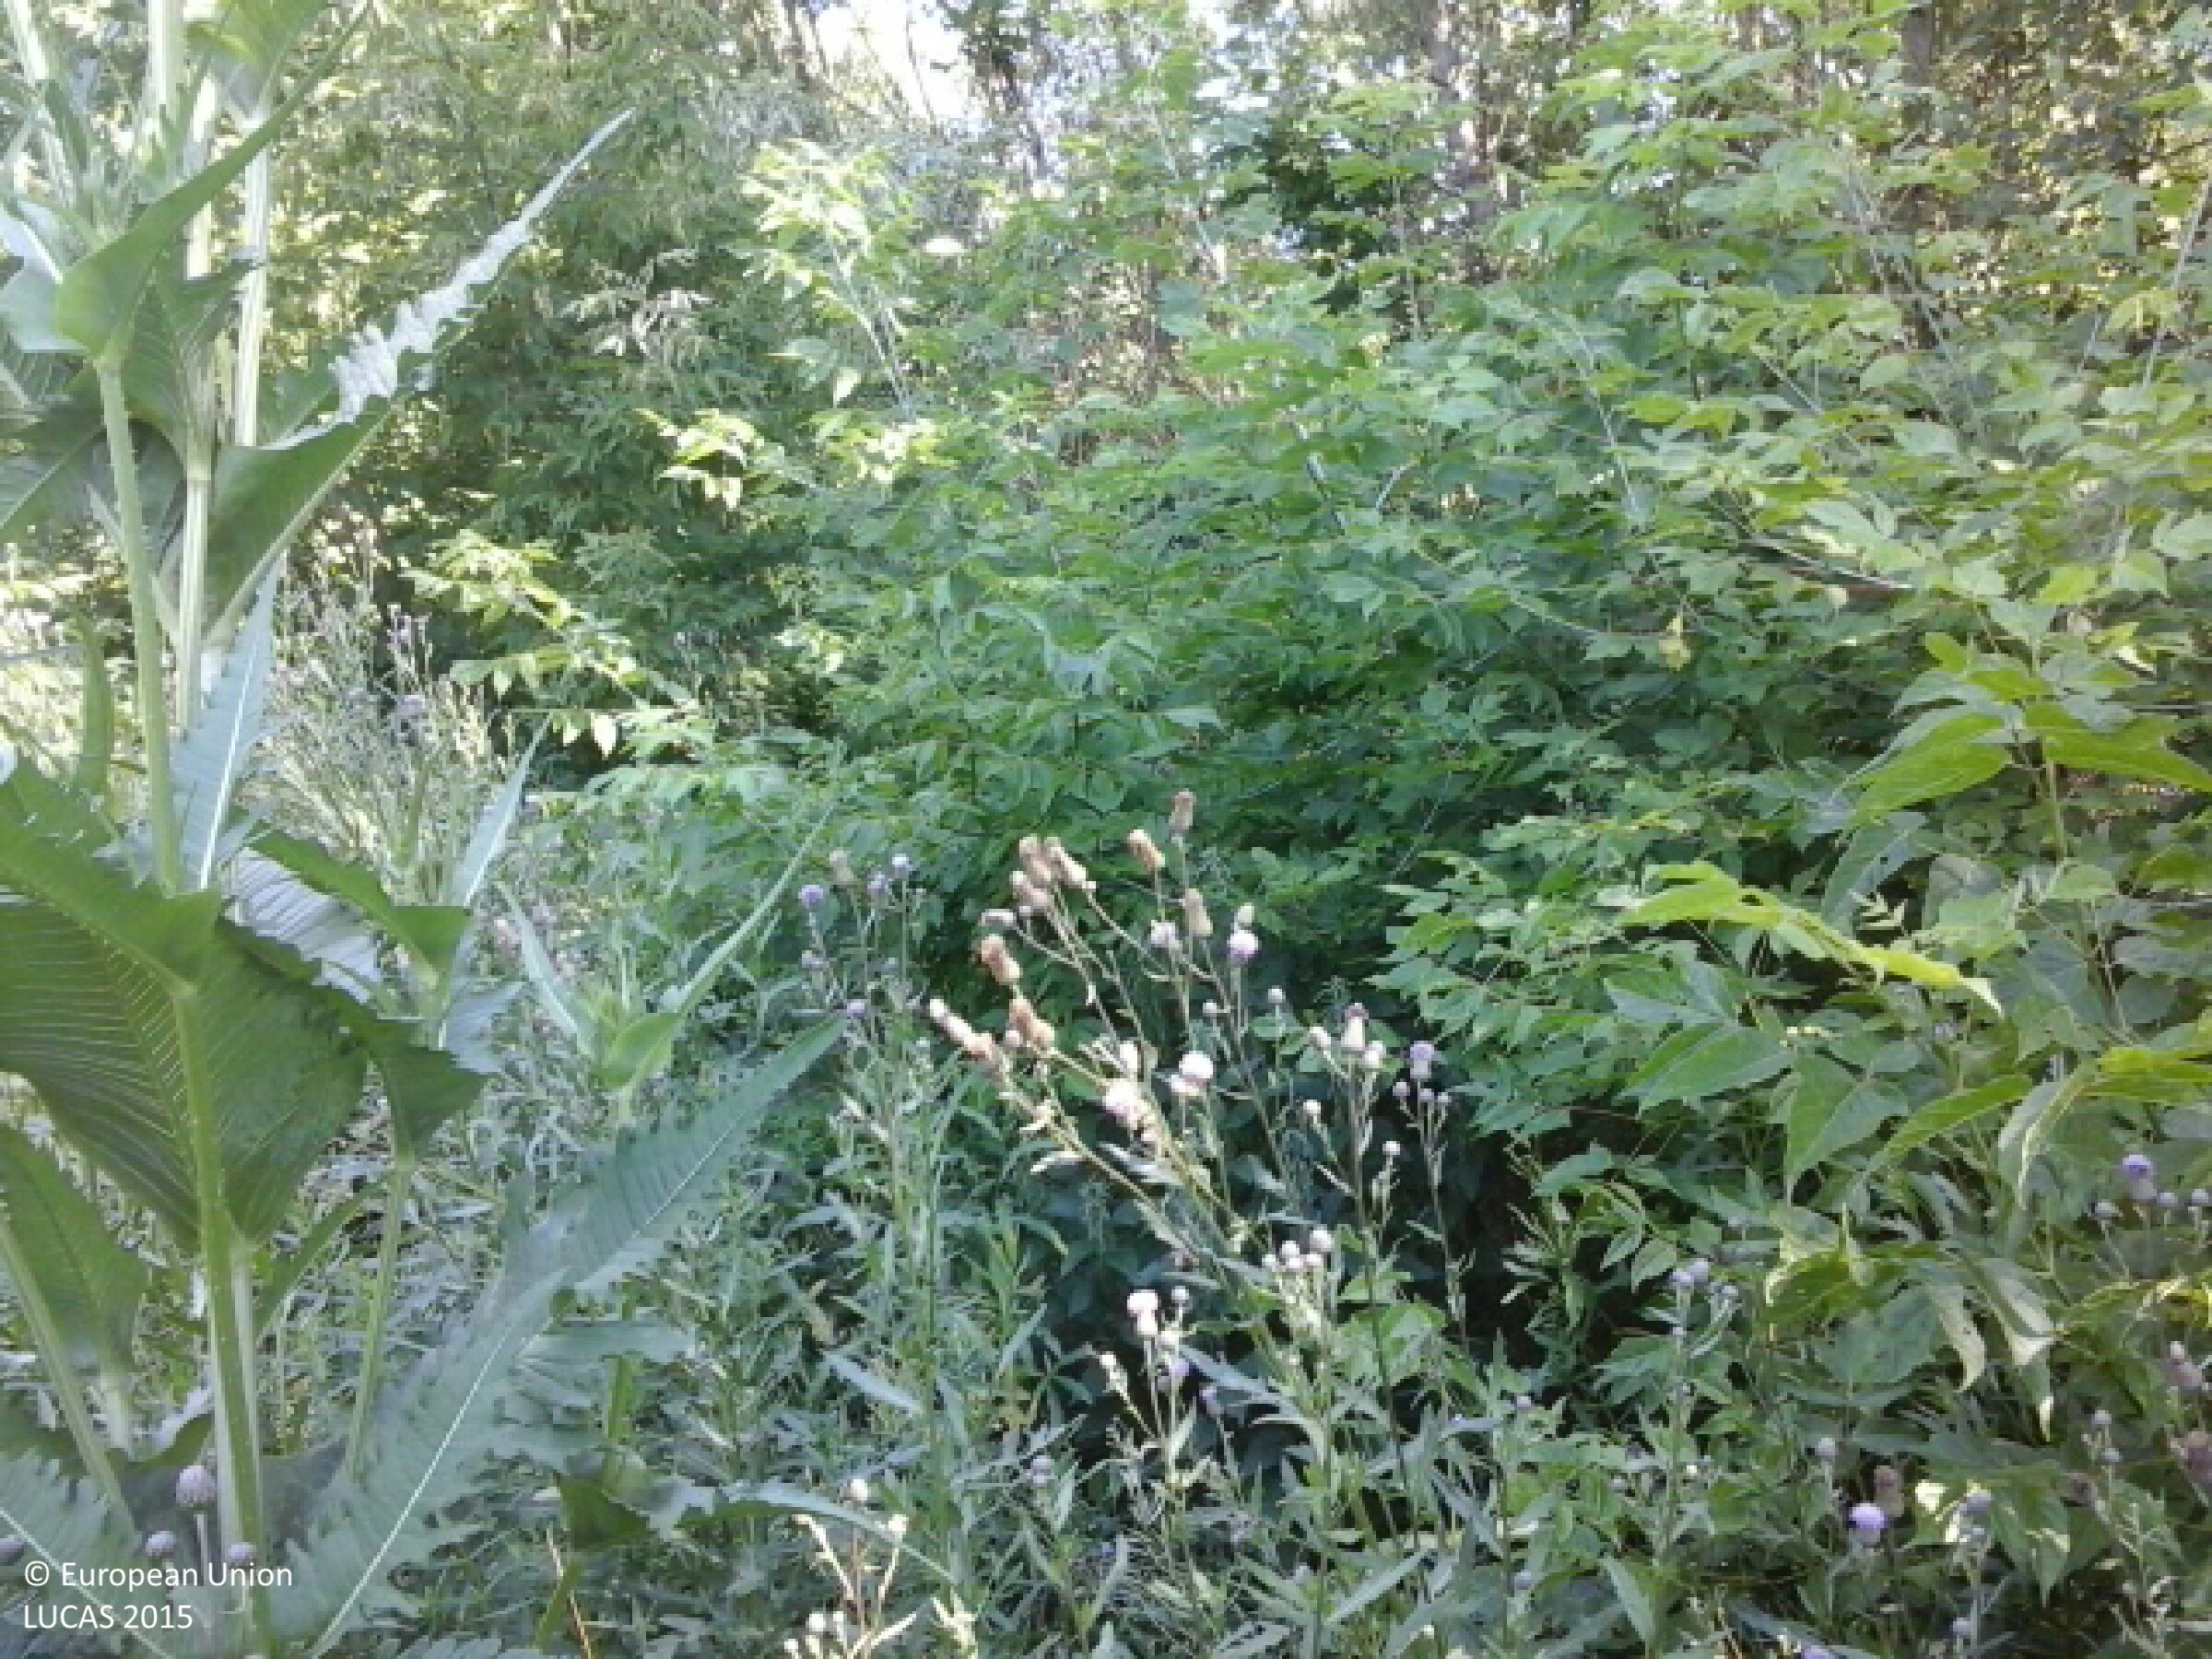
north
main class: Woodland
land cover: Broadleaved woodland
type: mesophytic deciduous forest
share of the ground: > 75 %
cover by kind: broadleaved forest trees 90 %, herbaceous plants 10 %
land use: Semi-natural and natural areas not in use
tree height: > 5 m
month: July
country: HU
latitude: 48.3201
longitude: 21.5780
